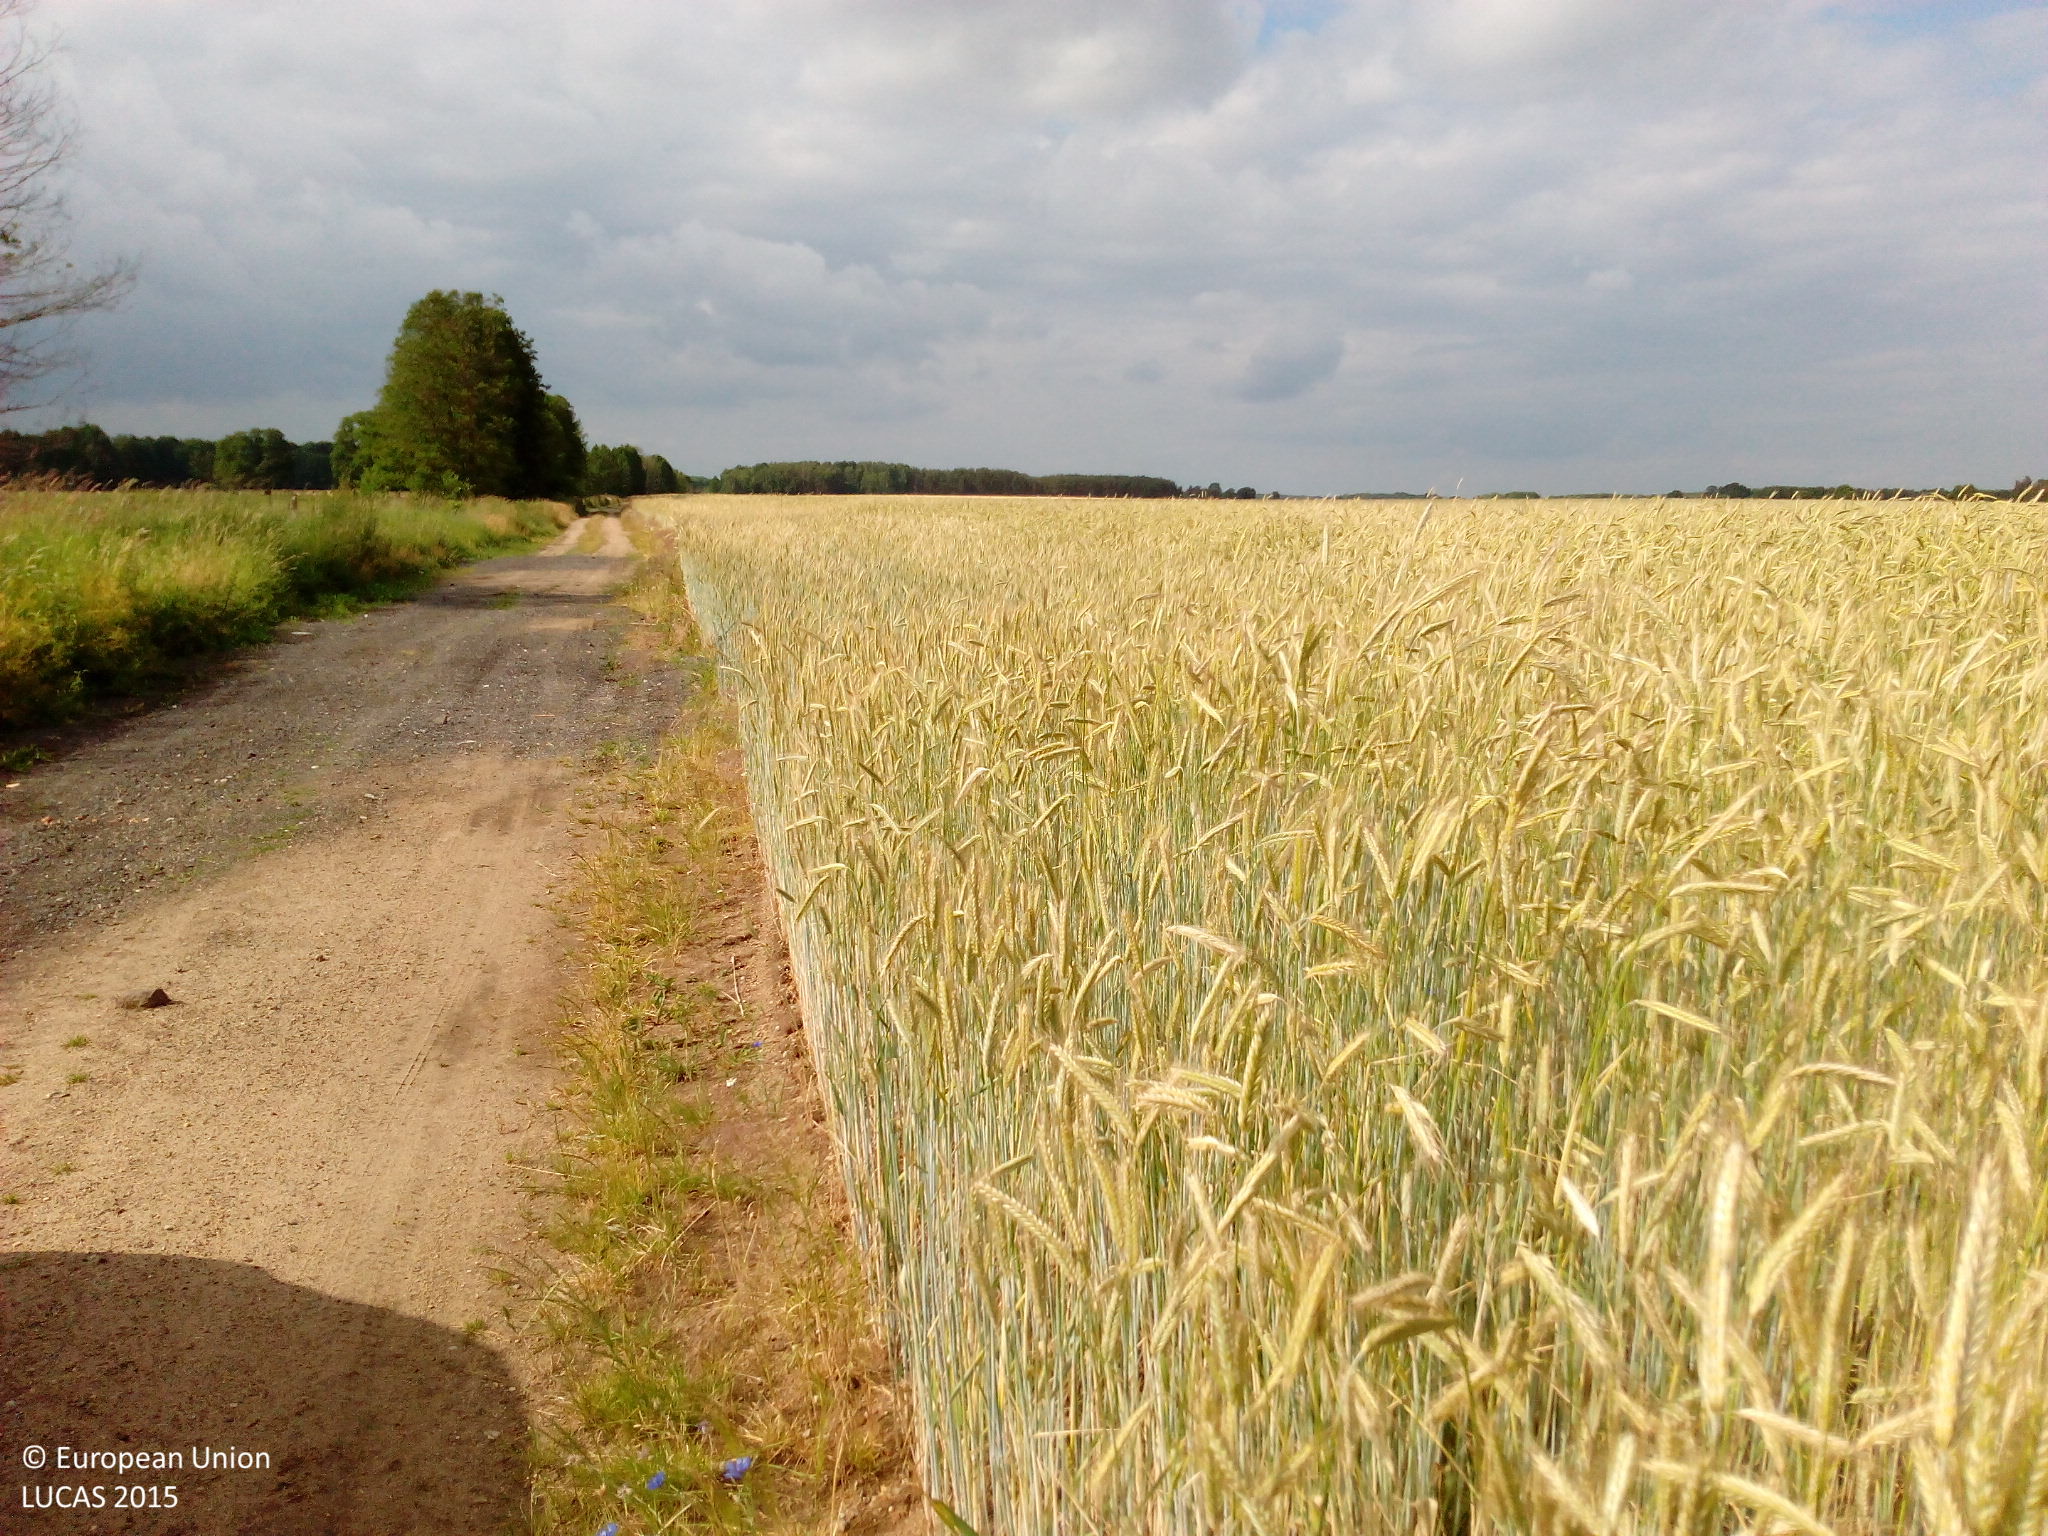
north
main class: Cropland
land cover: Rye
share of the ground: > 75 %
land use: Agriculture (excluding fallow land and kitchen gardens)
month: June
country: DE
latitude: 52.2468
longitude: 12.3284
